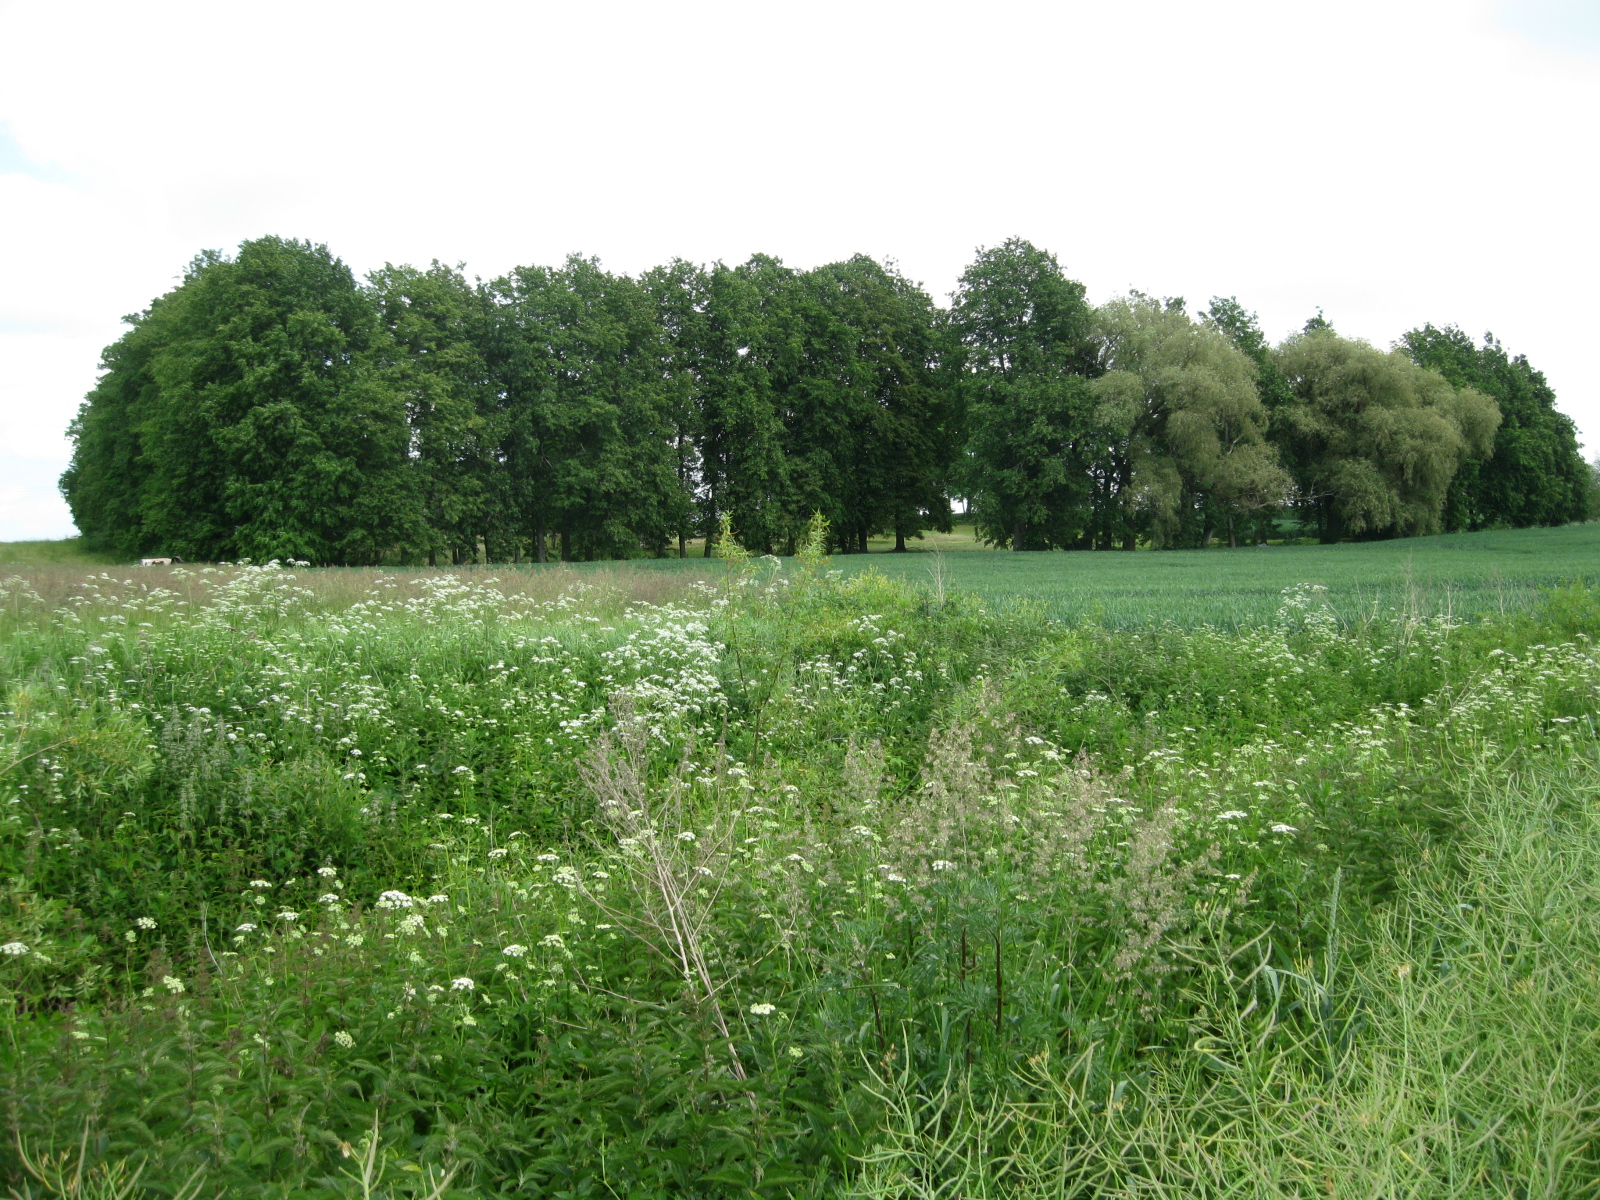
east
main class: Cropland
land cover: Rape and turnip rape
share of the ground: > 75 %
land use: Agriculture (excluding fallow land and kitchen gardens)
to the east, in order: Rape and turnip rape; Spontaneously vegetated surfaces; Ditches and canals; Grassland with sparse tree/shrub cover; Grassland without tree/shrub cover; Common wheat; Broadleaved woodland; Artificial constructions in urban areas; Broadleaved woodland; Common wheat
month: June
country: LT
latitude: 55.5371
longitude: 23.8882
